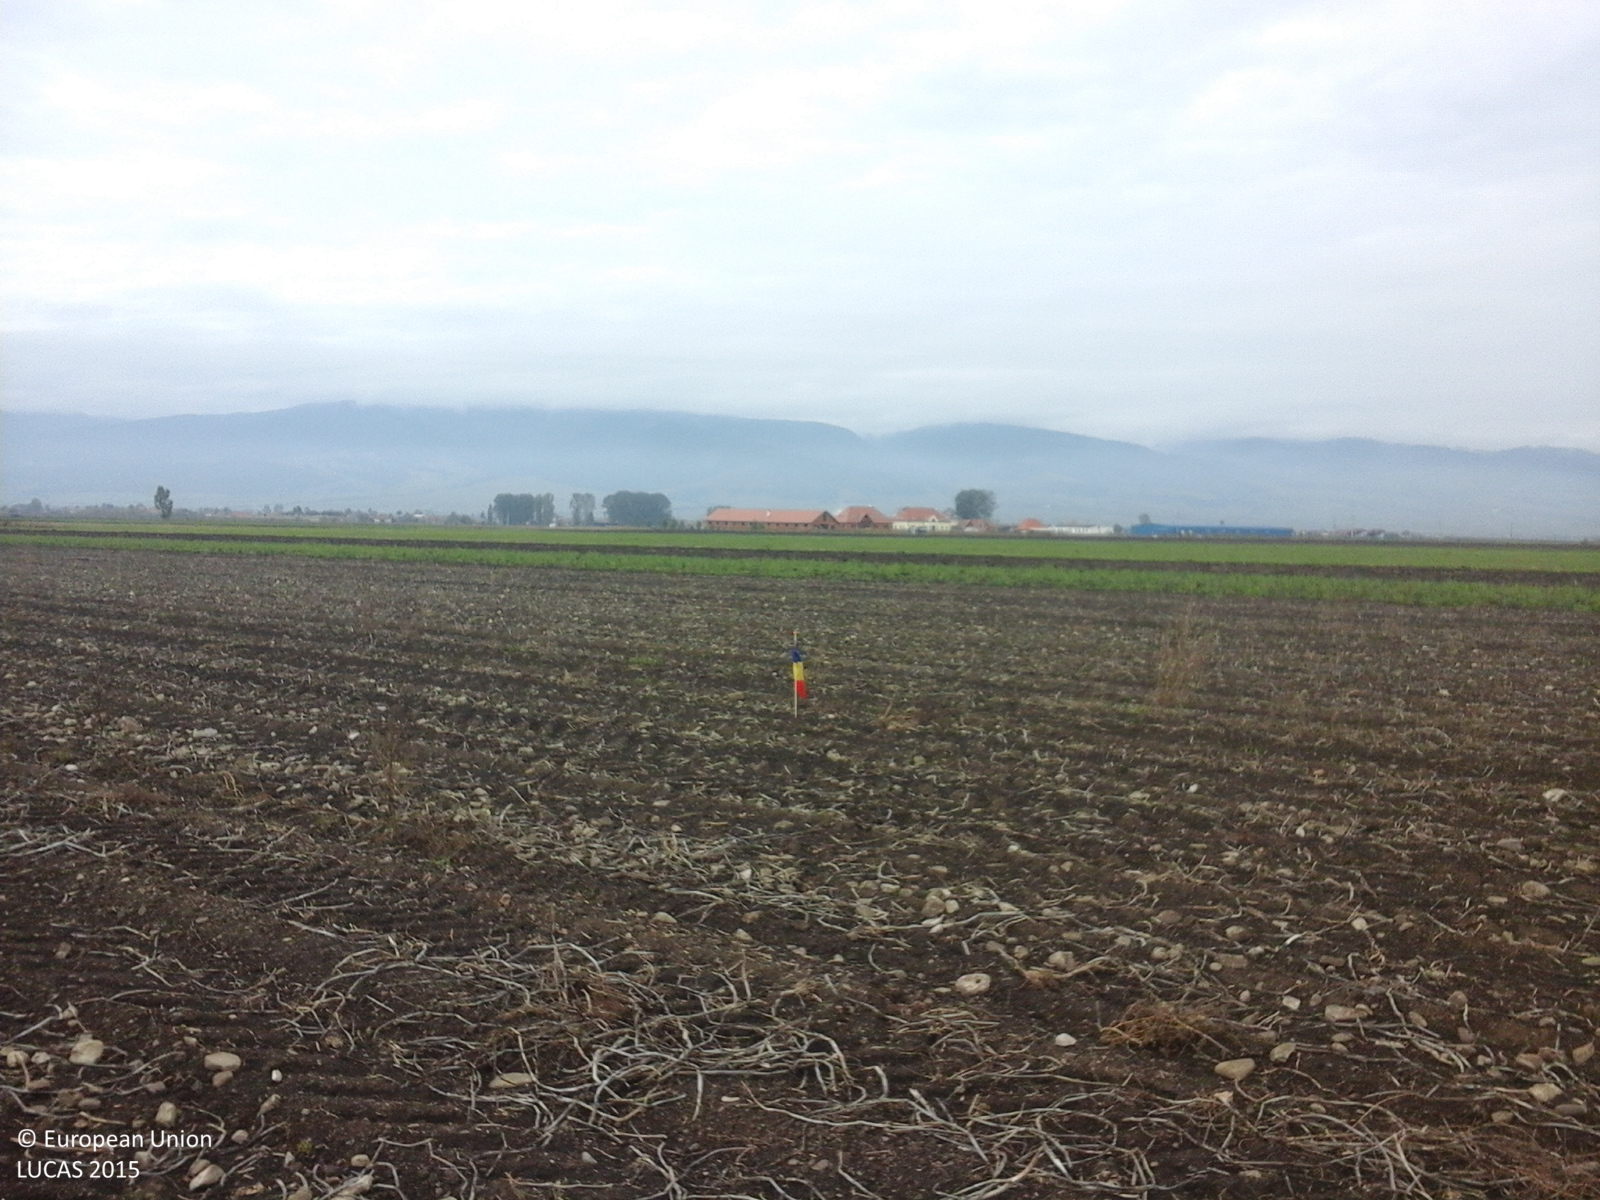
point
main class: Cropland
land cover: Potatoes
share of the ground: < 10 %
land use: Agriculture (excluding fallow land and kitchen gardens)
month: October
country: RO
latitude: 46.2699
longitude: 25.9083
